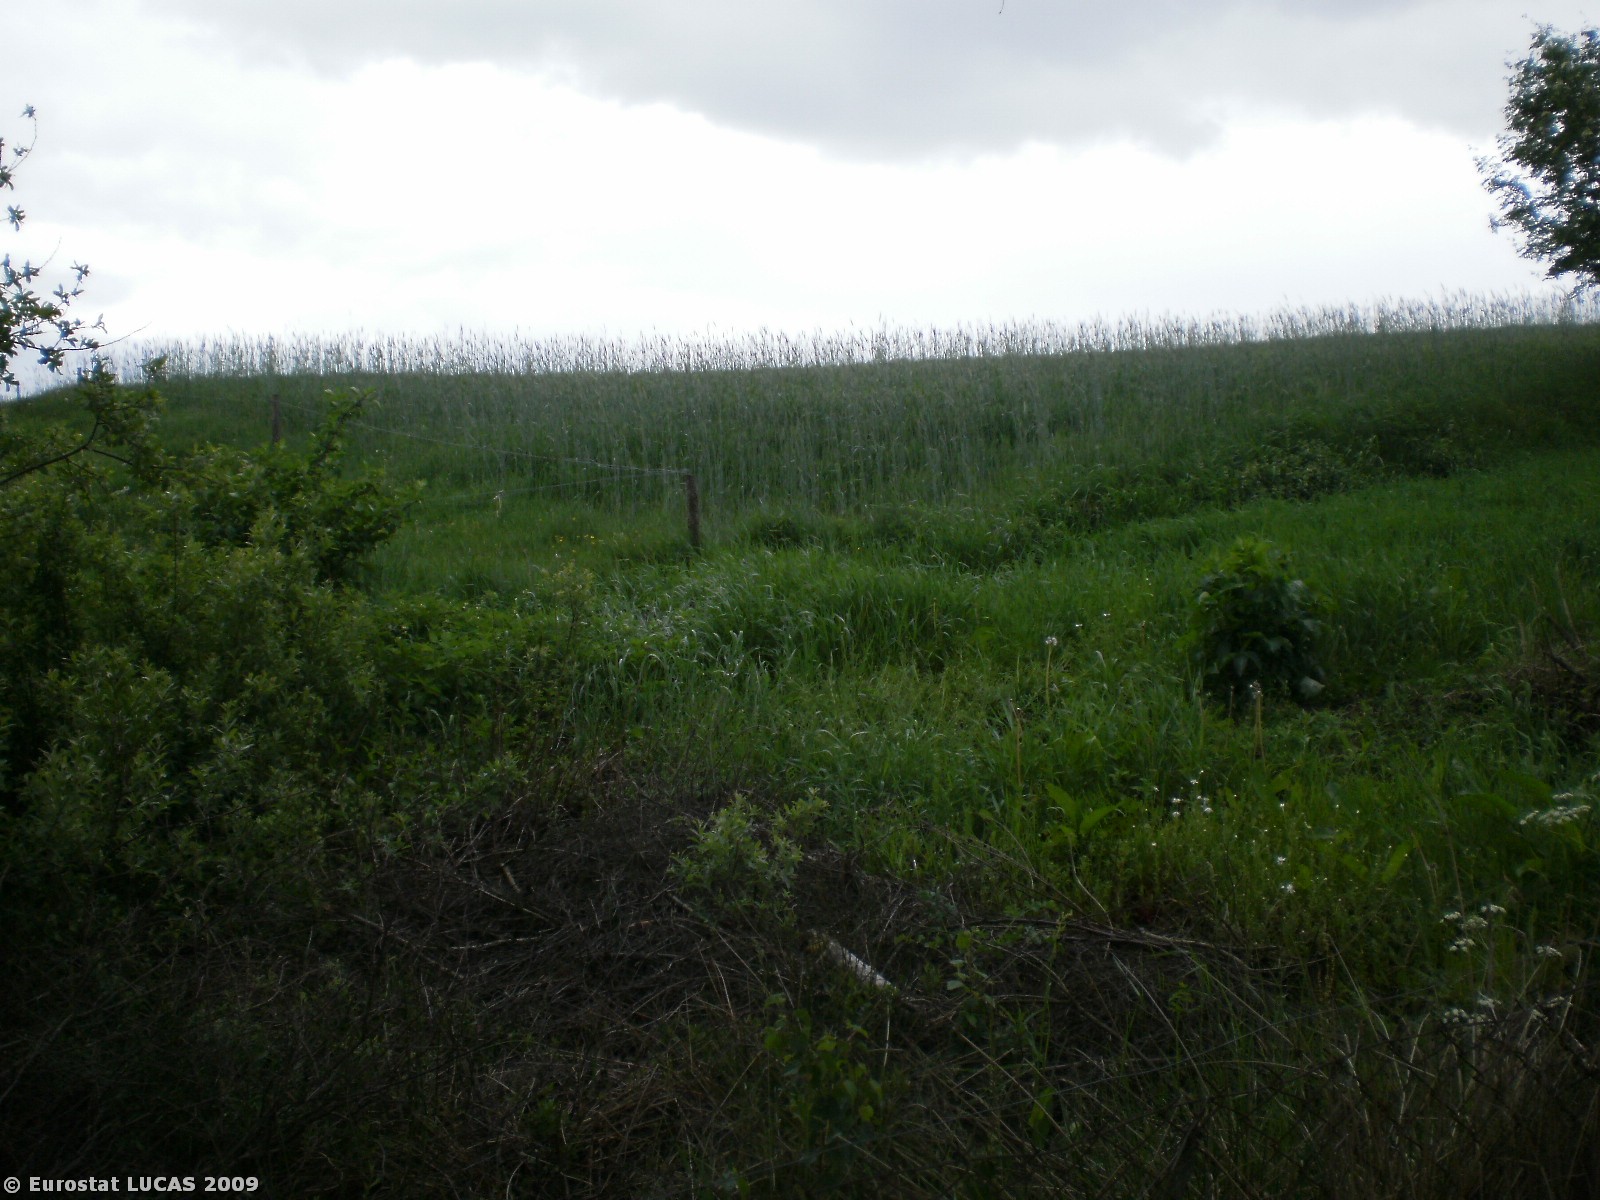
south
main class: Grassland
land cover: Grassland with sparse tree/shrub cover
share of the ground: > 75 %
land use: Agriculture (excluding fallow land and kitchen gardens)
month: May
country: PL
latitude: 54.0344
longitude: 18.0916
